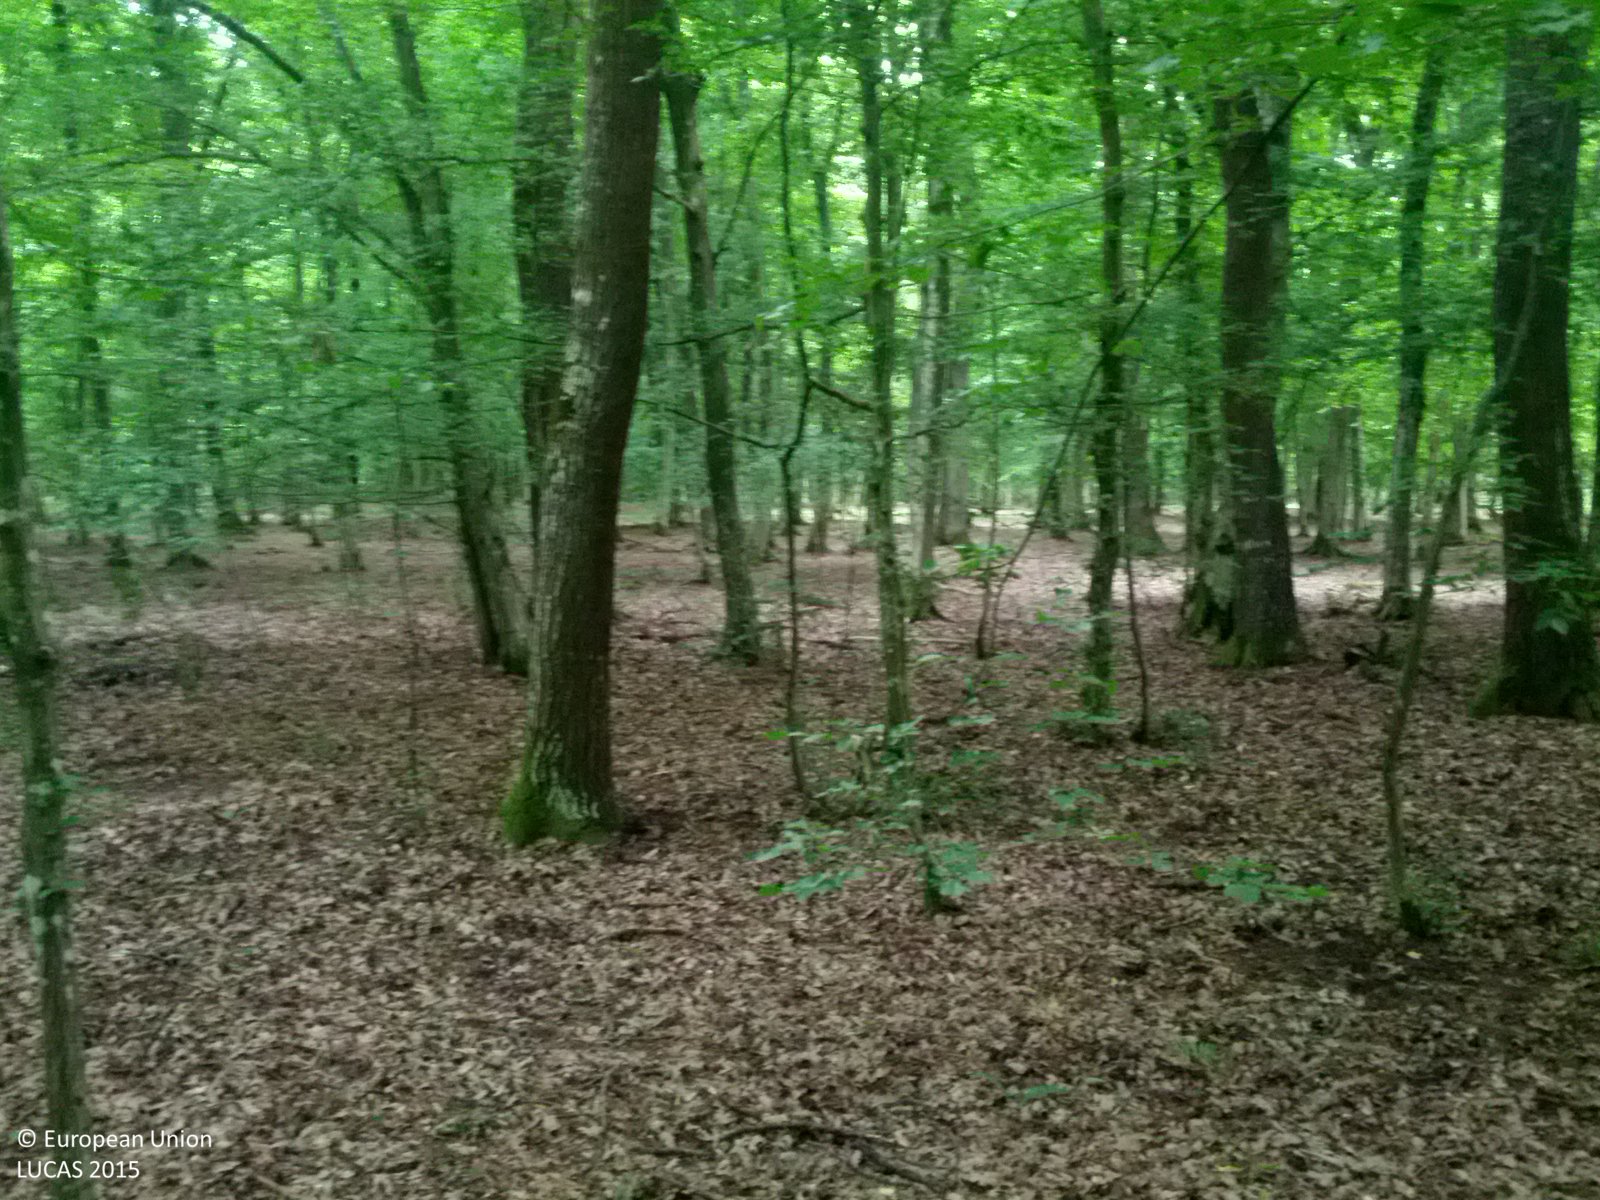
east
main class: Woodland
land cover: Broadleaved woodland
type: beech forest
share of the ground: > 75 %
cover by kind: broadleaved forest trees 90 %, herbaceous plants 5 %, unconsolidated bare surface 5 %
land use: Forestry
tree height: > 5 m
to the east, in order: Broadleaved woodland; Tracks; Broadleaved woodland; Tracks; Spruce dominated coniferous woodland
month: June
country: AT
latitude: 47.0812
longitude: 16.3903
